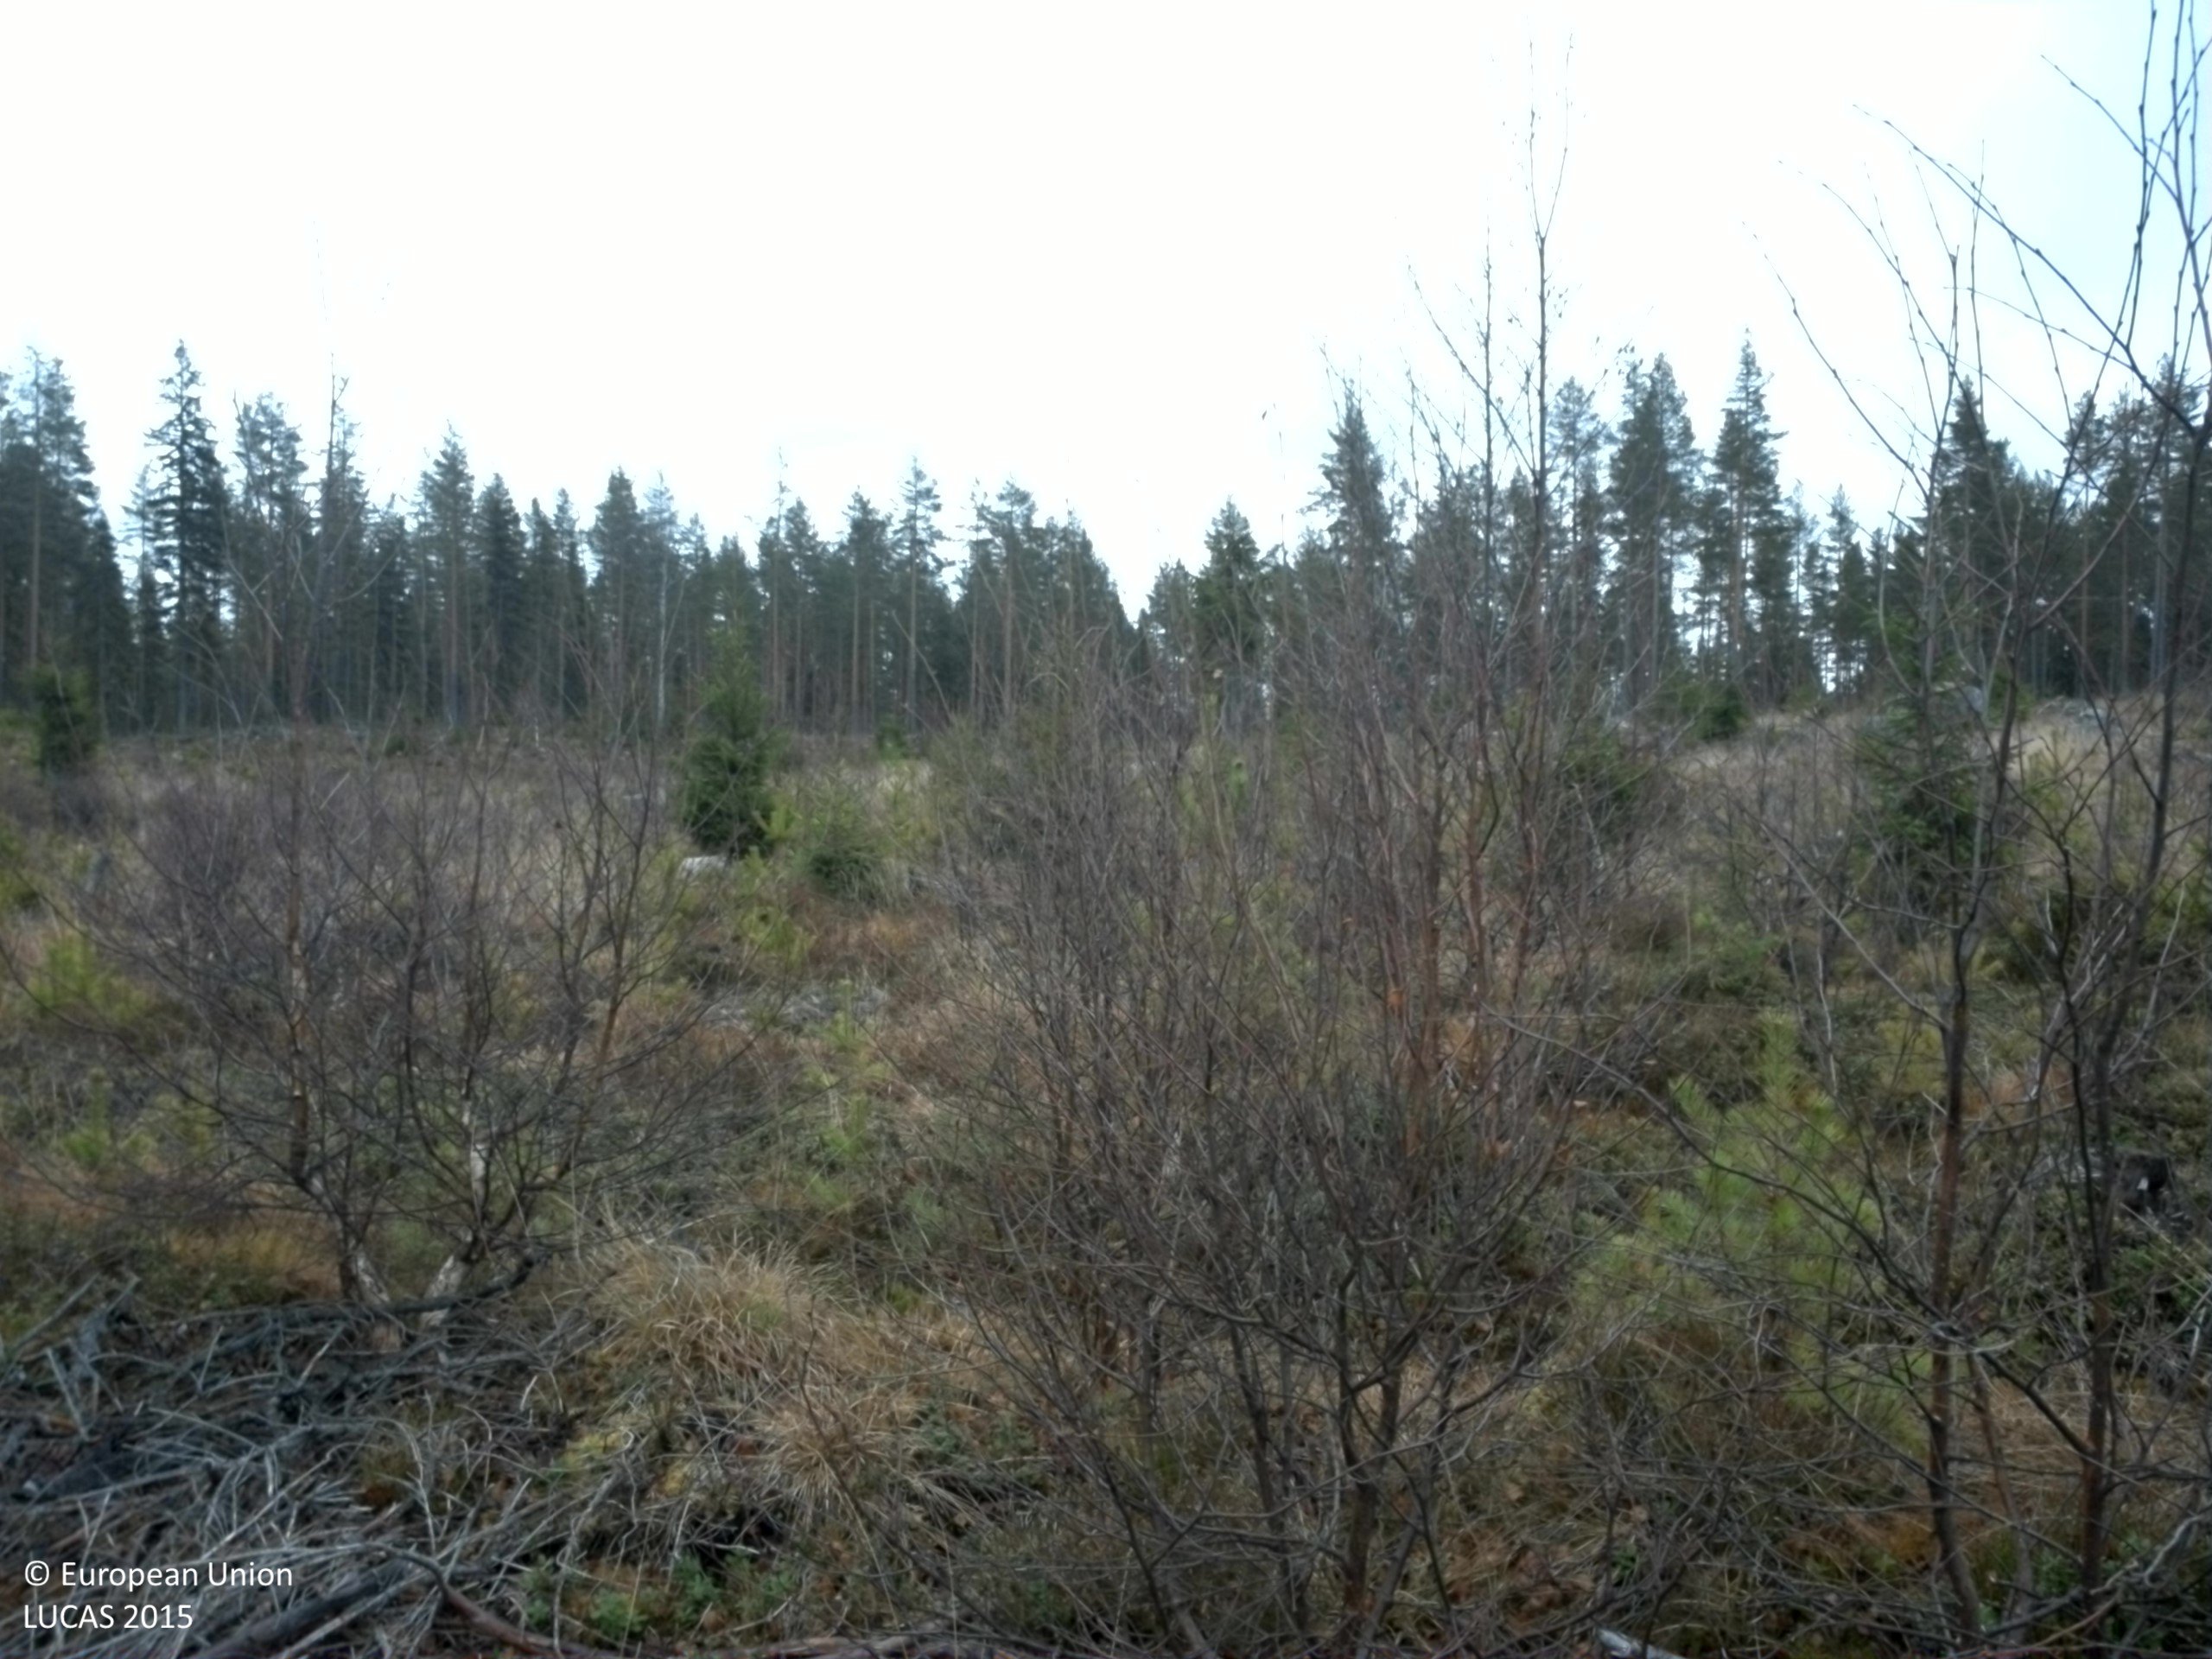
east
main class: Woodland
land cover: Pine dominated mixed woodland
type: boreal forest
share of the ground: 25 - 50 %
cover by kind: herbaceous plants 30 %, shrubs 25 %, coniferous forest trees 15 %, broadleaved forest trees 10 %, lichens and mosses 10 %, consolidated bare surface 5 %, unconsolidated bare surface 5 %
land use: Forestry
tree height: < 5 m
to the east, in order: Pine dominated mixed woodland; Other mixed woodland; Pine dominated coniferous woodland
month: November
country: SE
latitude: 61.5854
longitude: 16.8979
